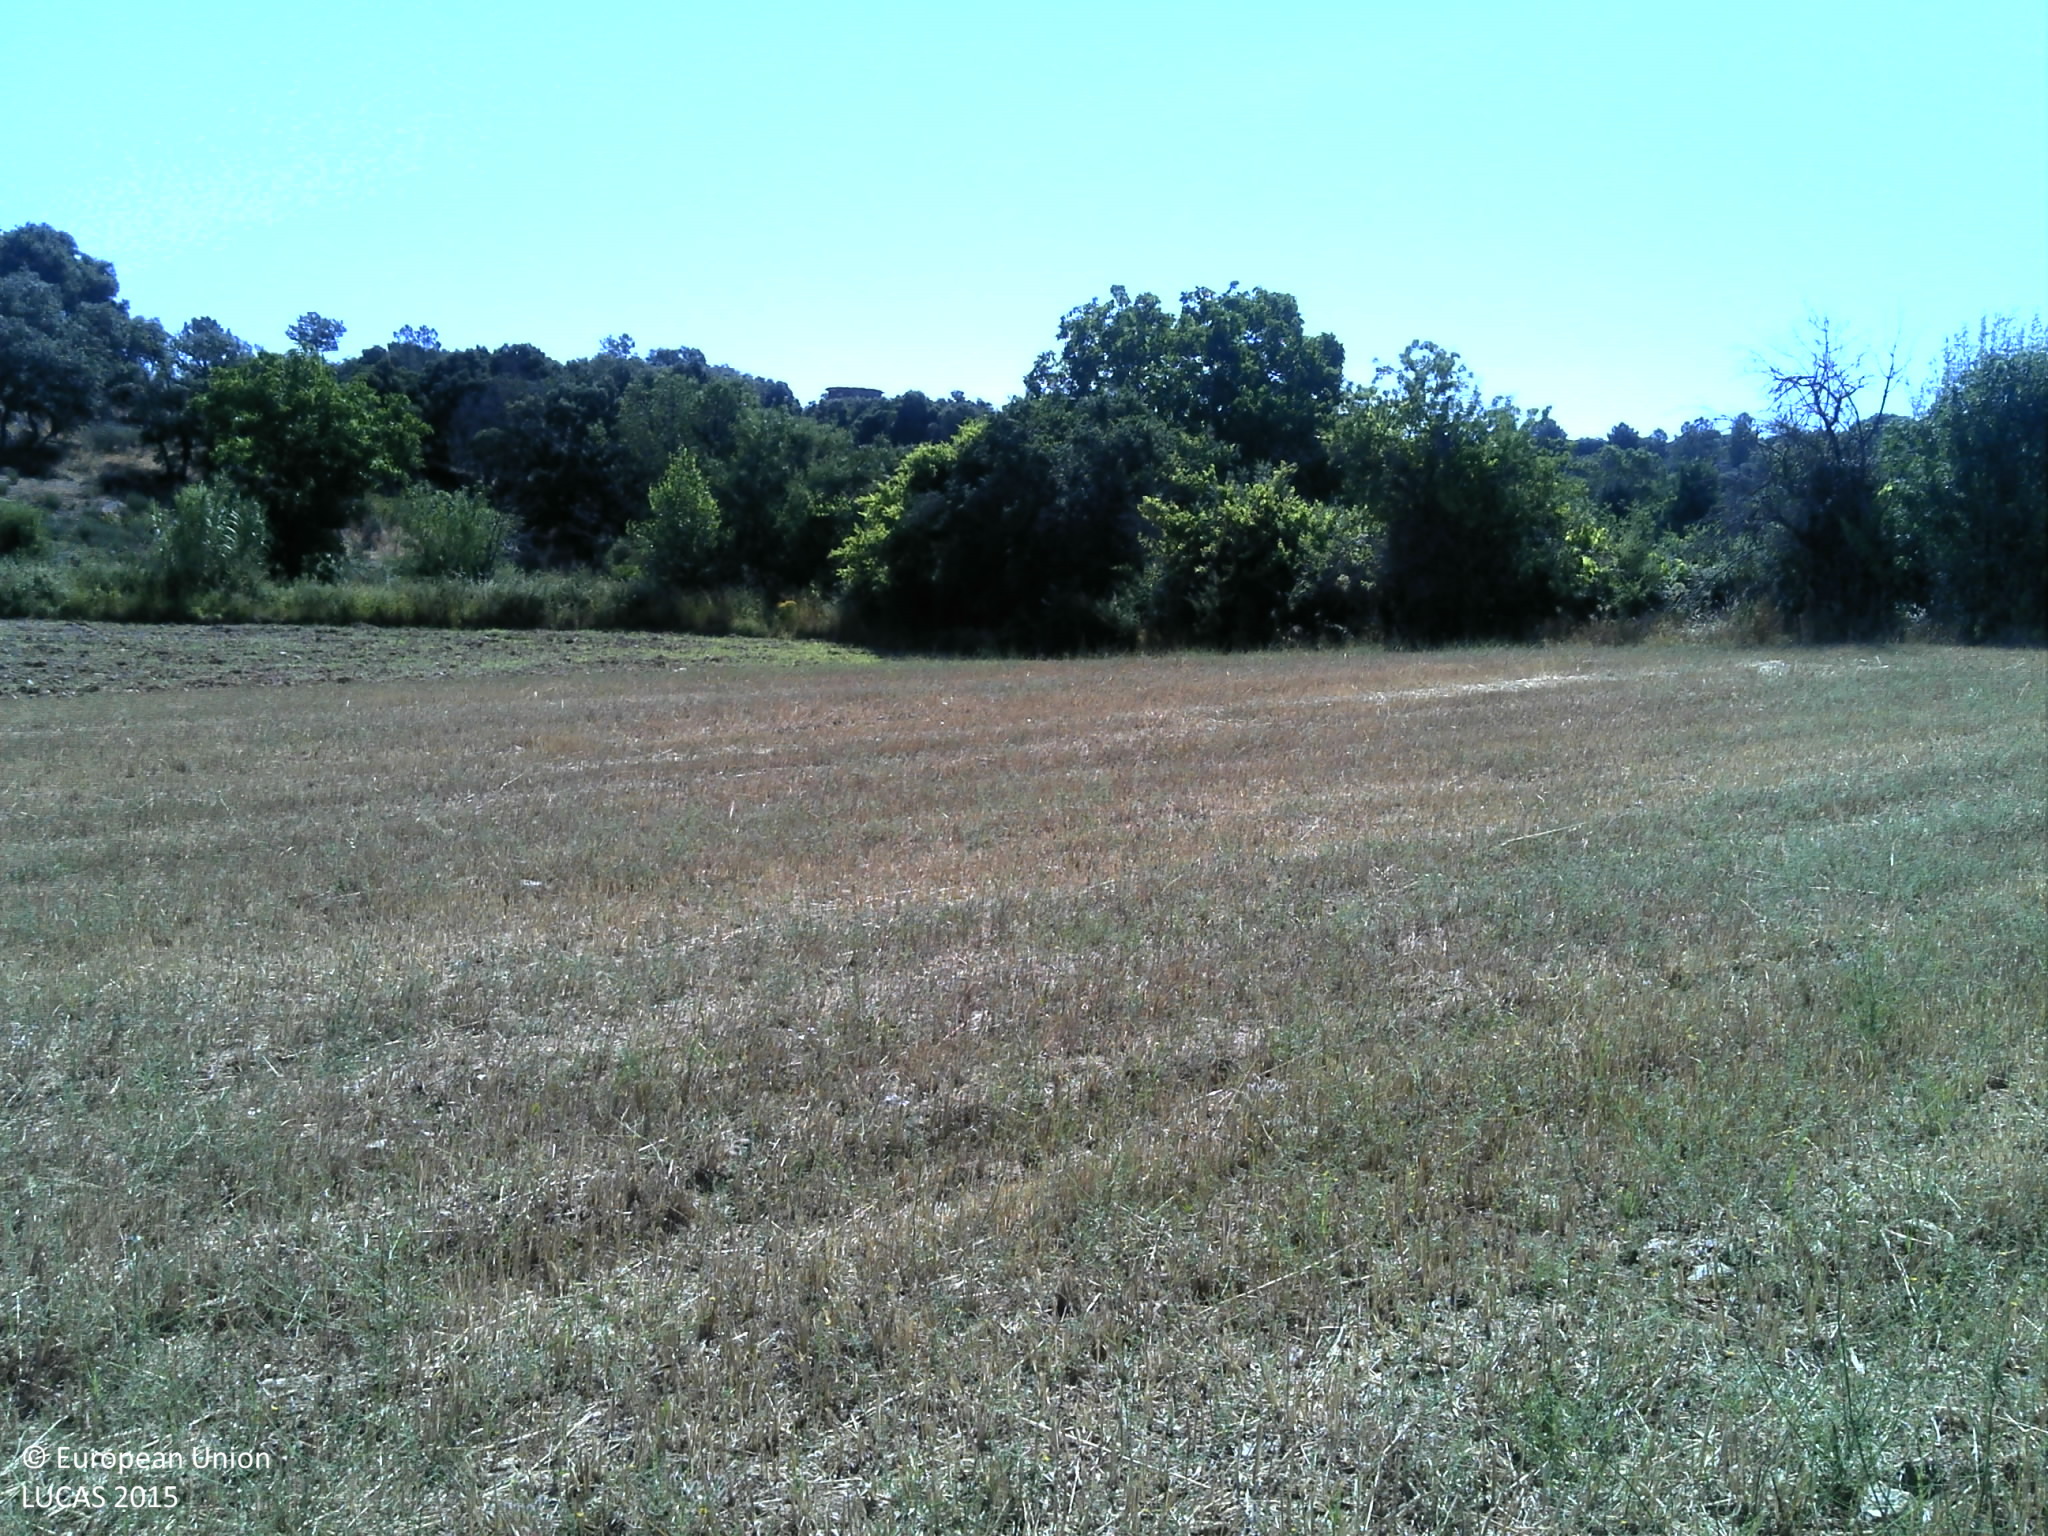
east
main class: Cropland
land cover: Oats
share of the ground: > 75 %
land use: Agriculture (excluding fallow land and kitchen gardens)
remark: Harvested field
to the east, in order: Oats; Maize; Shruby margins; Abandoned hedges; Rivers and streams; Grassland without tree/shrub cover; Abandoned hedges; Grassland without tree/shrub cover; Grassland with sparse tree/shrub cover; Dry stone walls; Abandoned hedges; Shrubland without tree cover; Shrubland with sparse tree cover; Broadleaved woodland; Artificial constructions in urban areas; Shrubland with sparse tree cover; Broadleaved woodland; Tracks; Broadleaved woodland
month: June
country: PT
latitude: 40.8801
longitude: -7.0645
